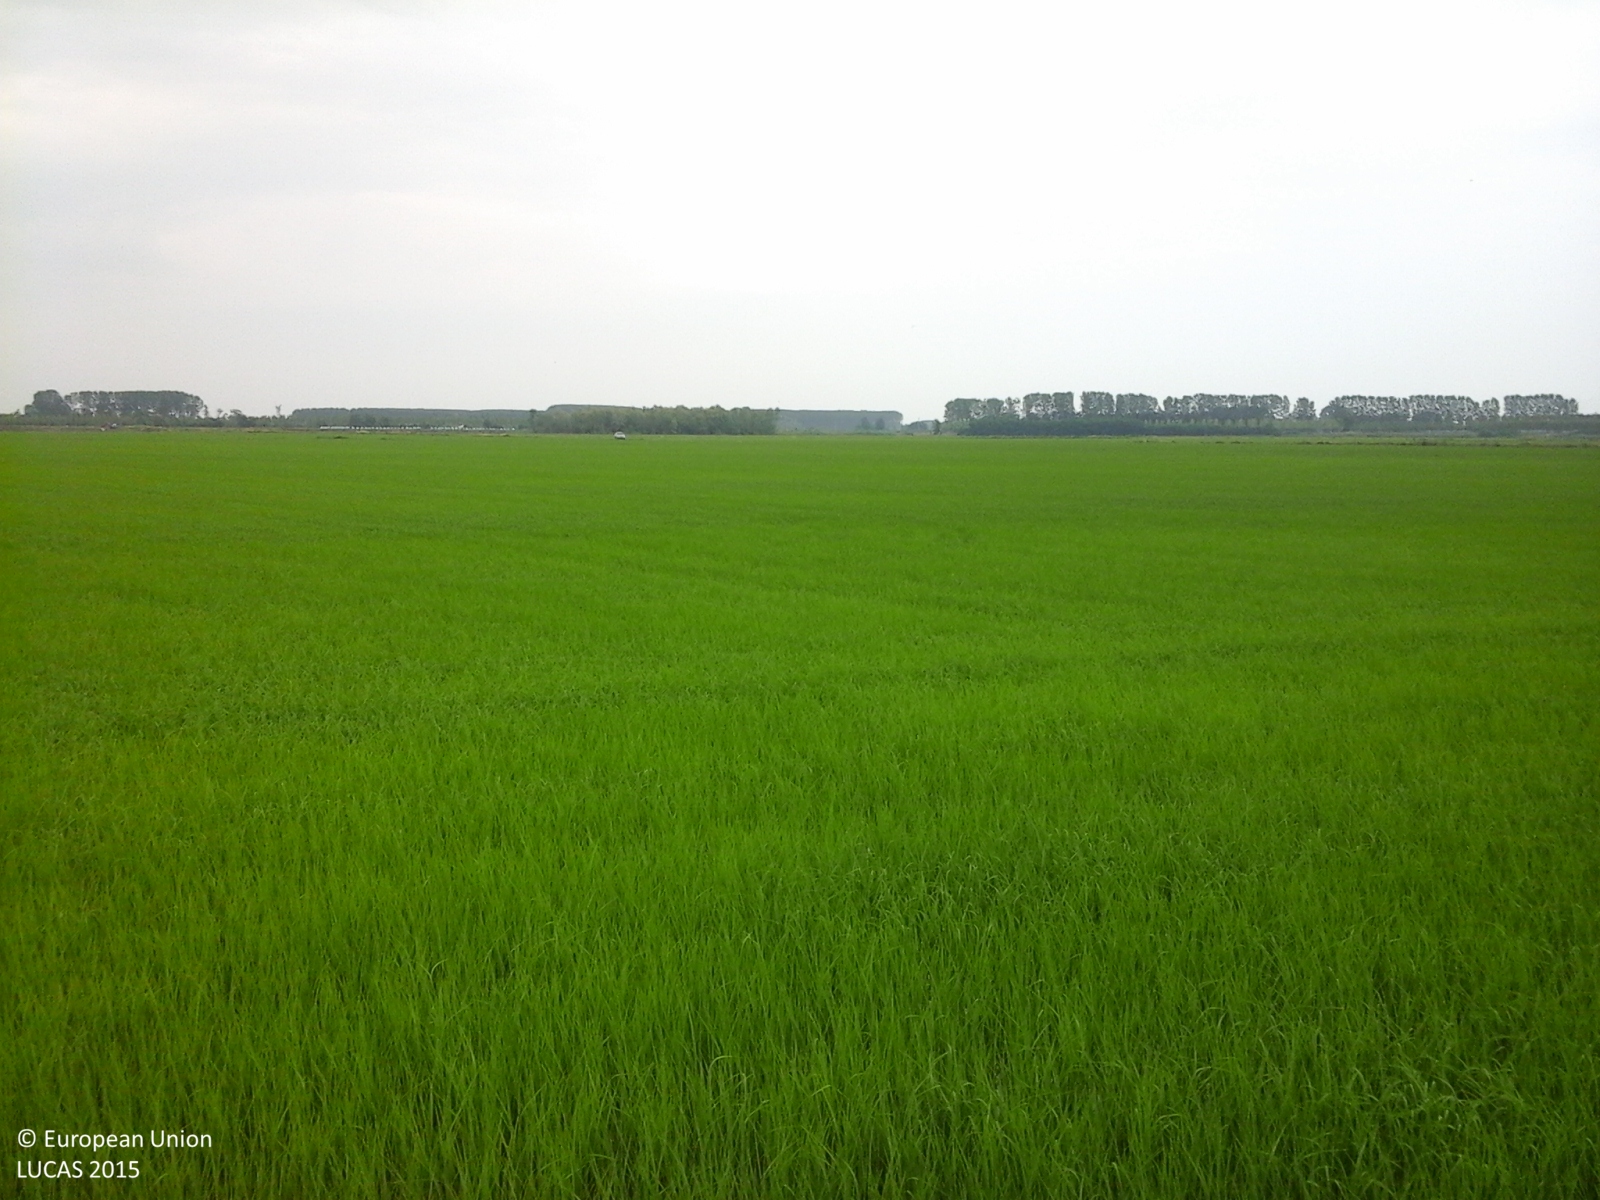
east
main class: Cropland
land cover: Rice
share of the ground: > 75 %
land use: Agriculture (excluding fallow land and kitchen gardens)
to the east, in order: Rice; Other structural elements; Rice
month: June
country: IT
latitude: 45.2783
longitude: 8.5620
